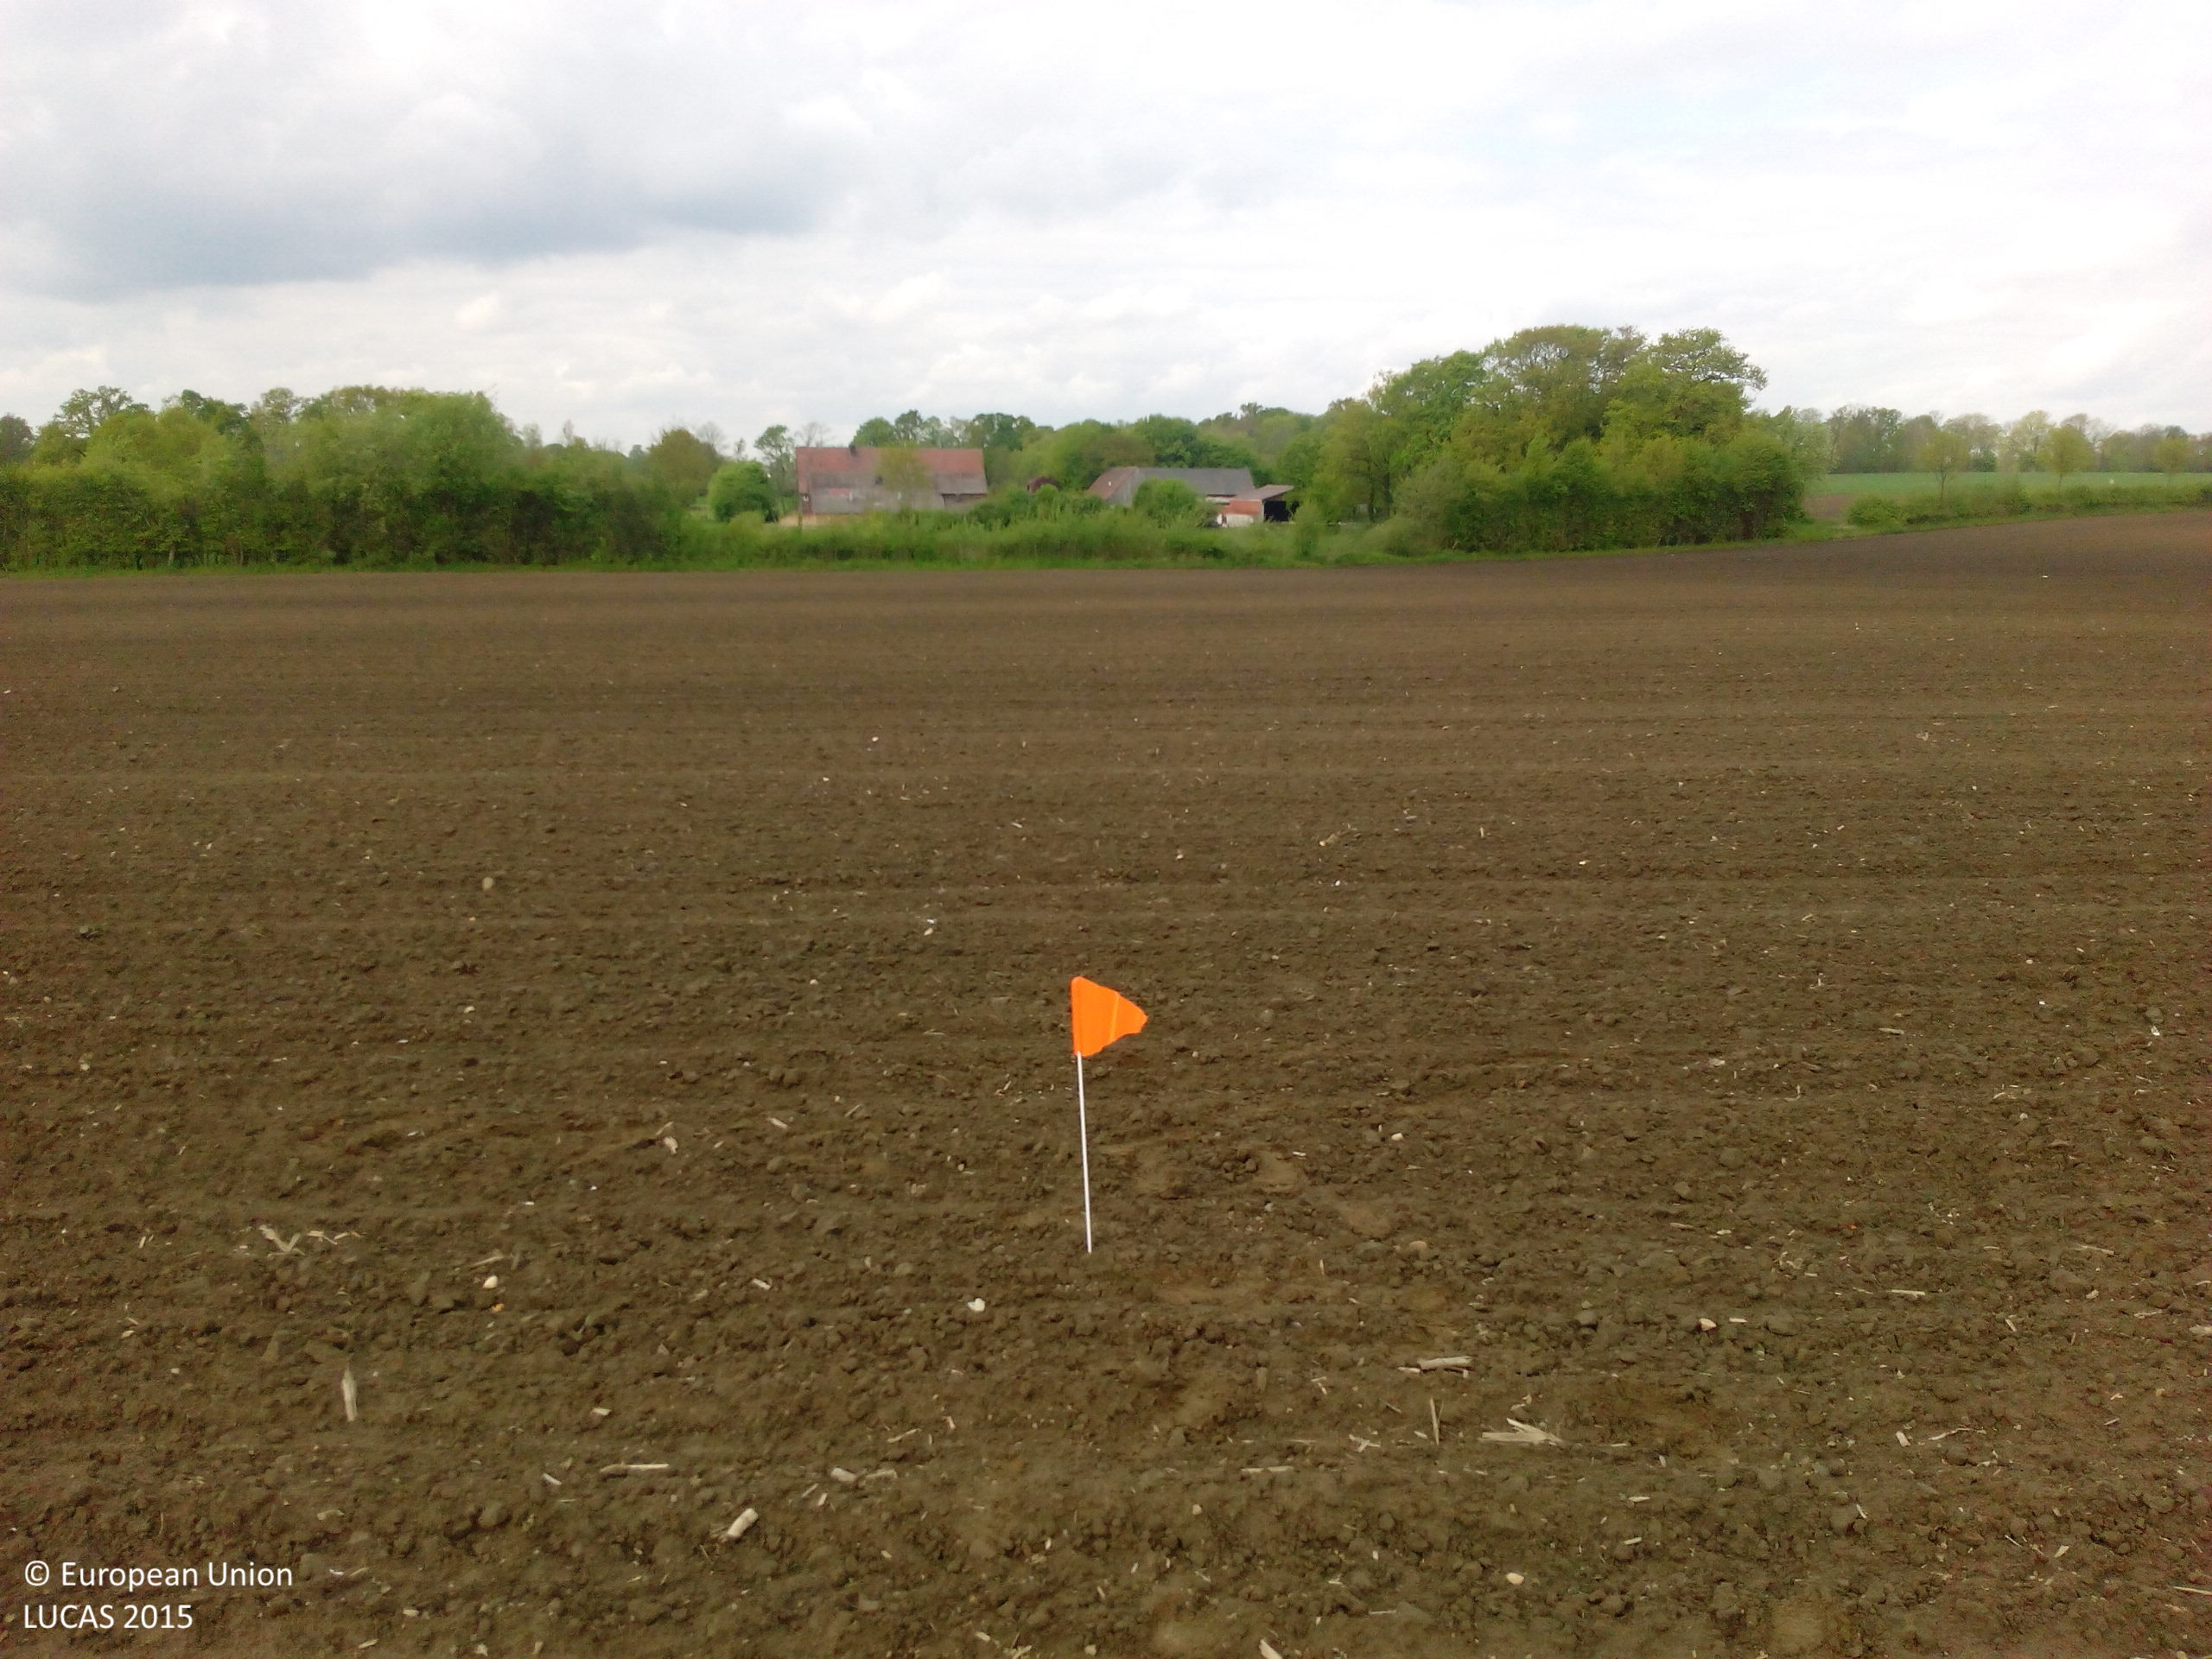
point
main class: Cropland
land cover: Maize
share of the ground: < 10 %
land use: Agriculture (excluding fallow land and kitchen gardens)
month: May
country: DE
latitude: 51.6832
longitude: 7.3823
